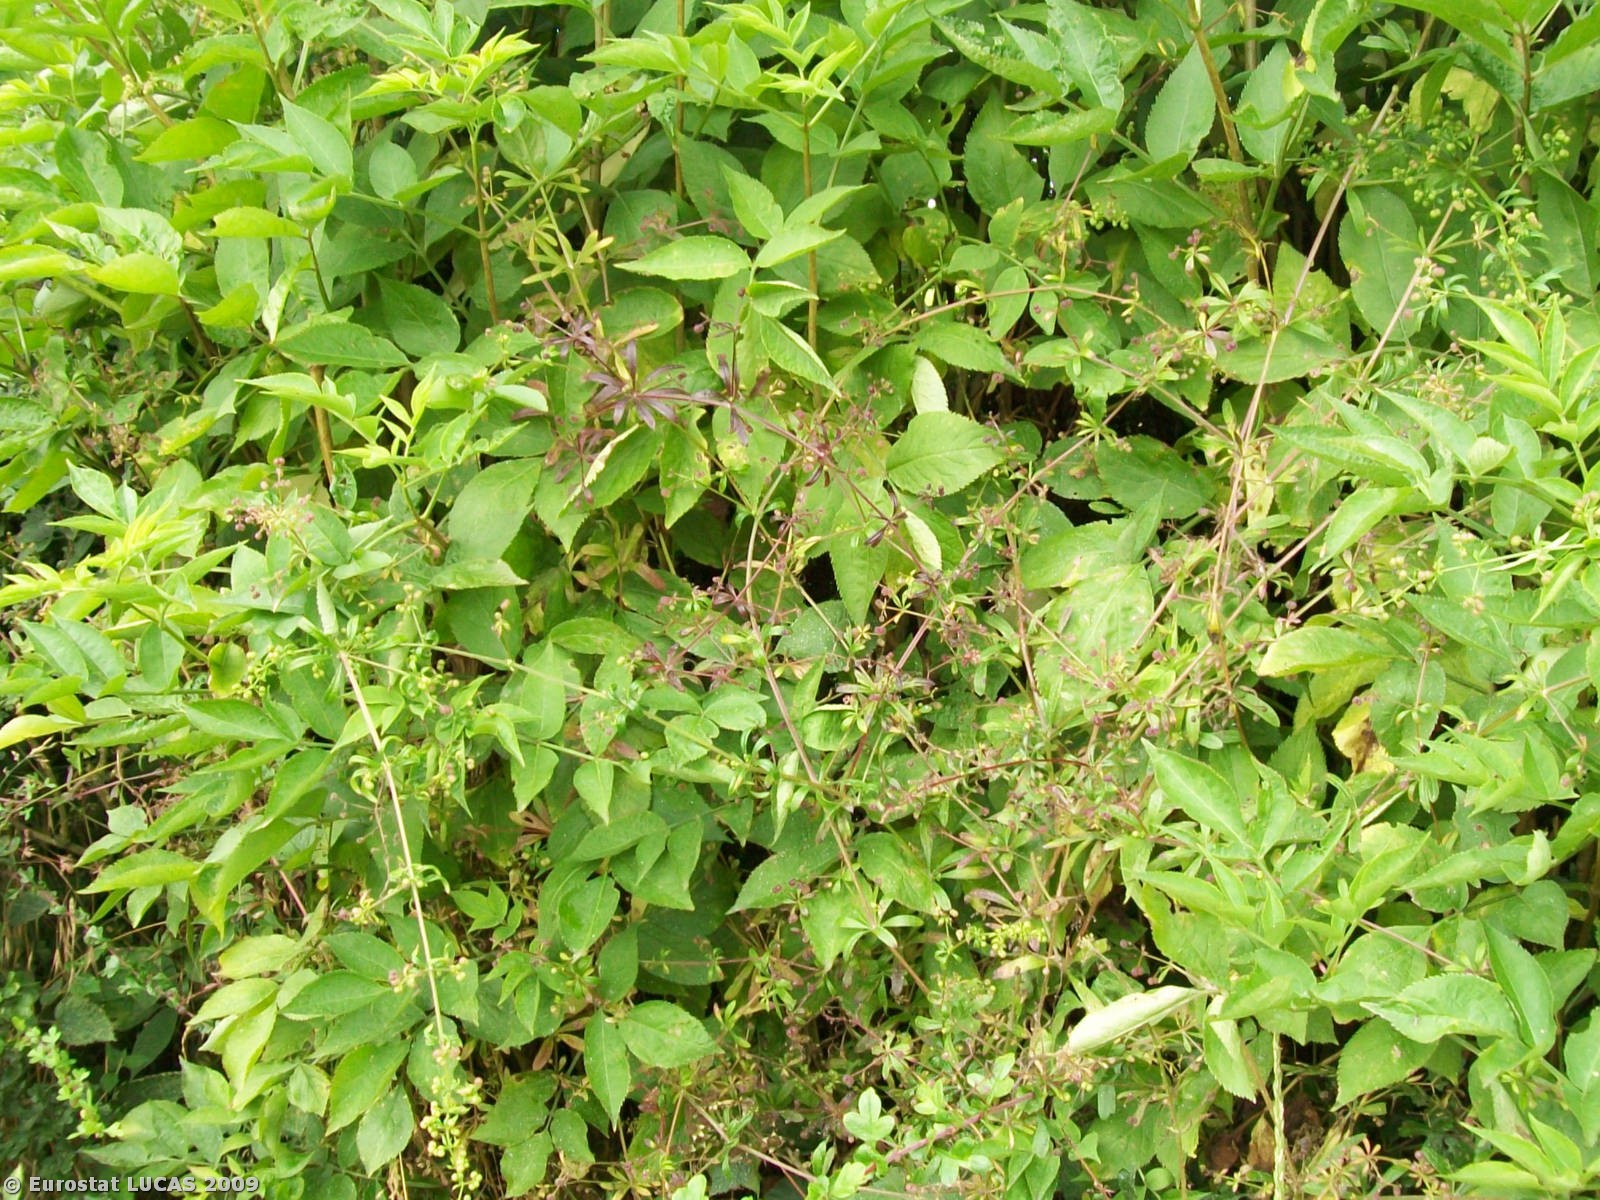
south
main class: Cropland
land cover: Common wheat
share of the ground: > 75 %
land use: Agriculture (excluding fallow land and kitchen gardens)
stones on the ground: < 10 %
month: July
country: GB
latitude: 52.6329
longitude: -1.3220
